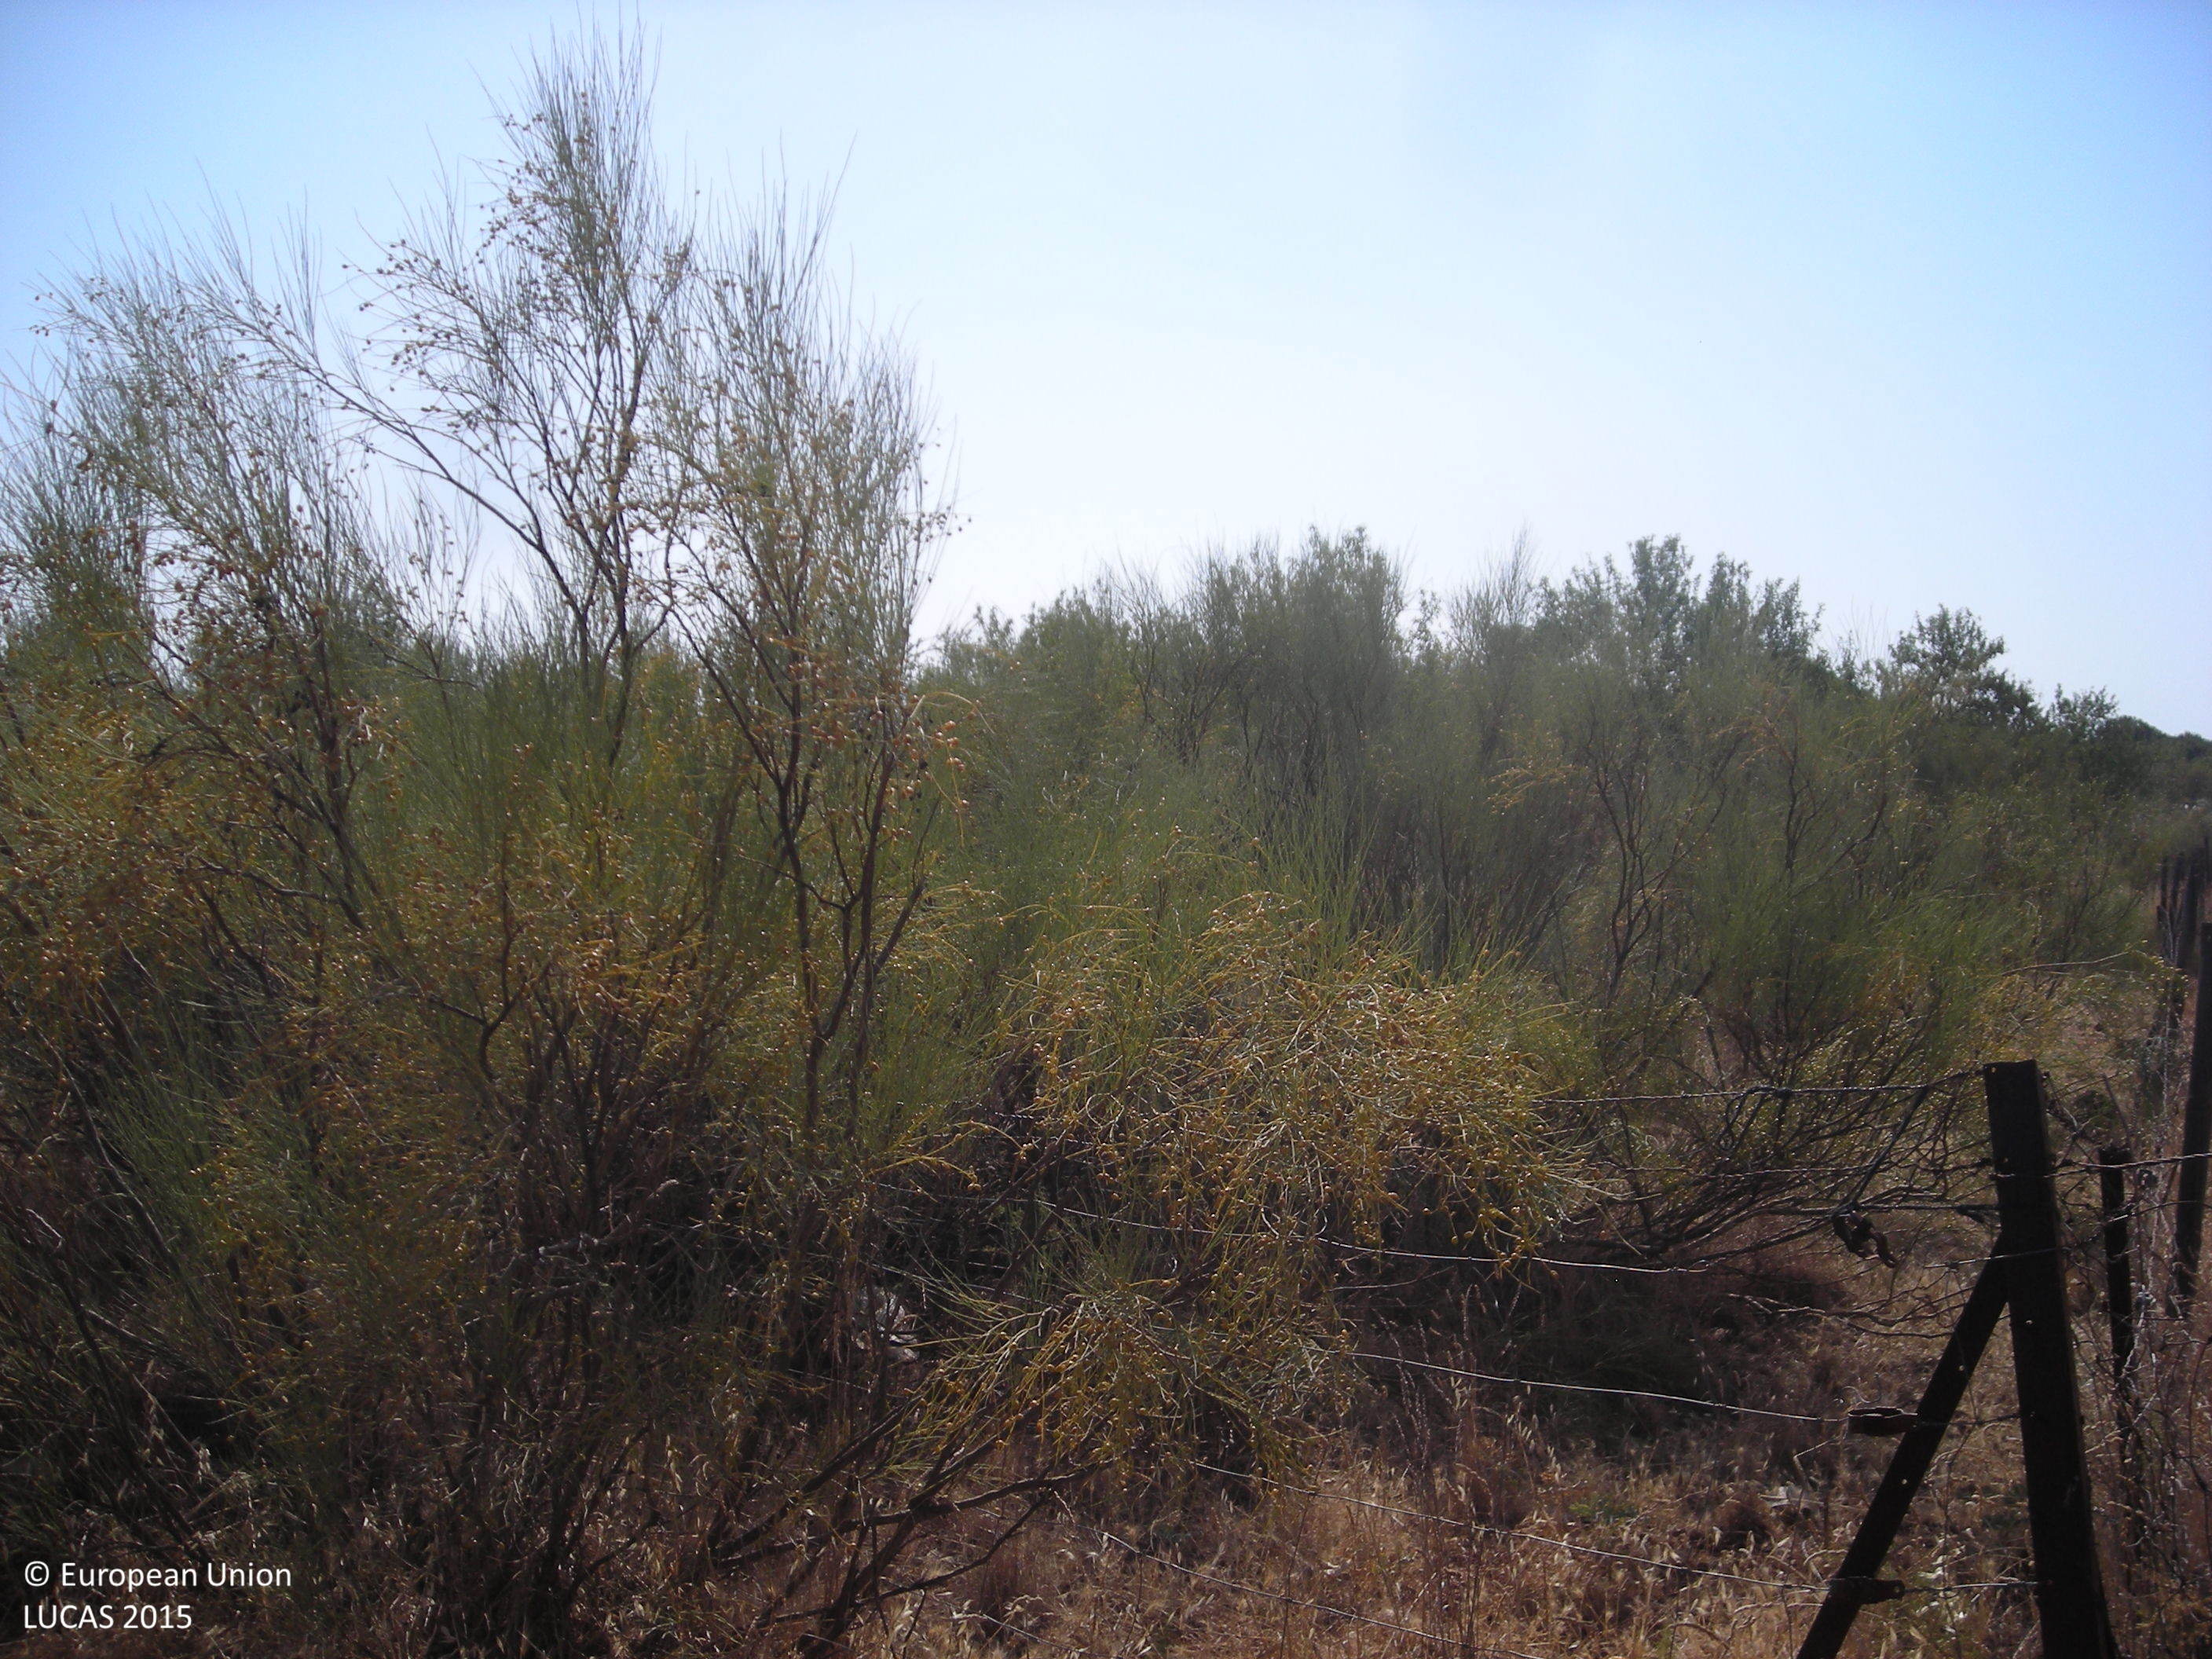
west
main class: Cropland
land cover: Olive groves
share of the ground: 25 - 50 %
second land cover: Other bare soil
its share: > 75 %
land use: Agriculture (excluding fallow land and kitchen gardens)
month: July
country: ES
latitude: 38.9101
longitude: -5.7651
